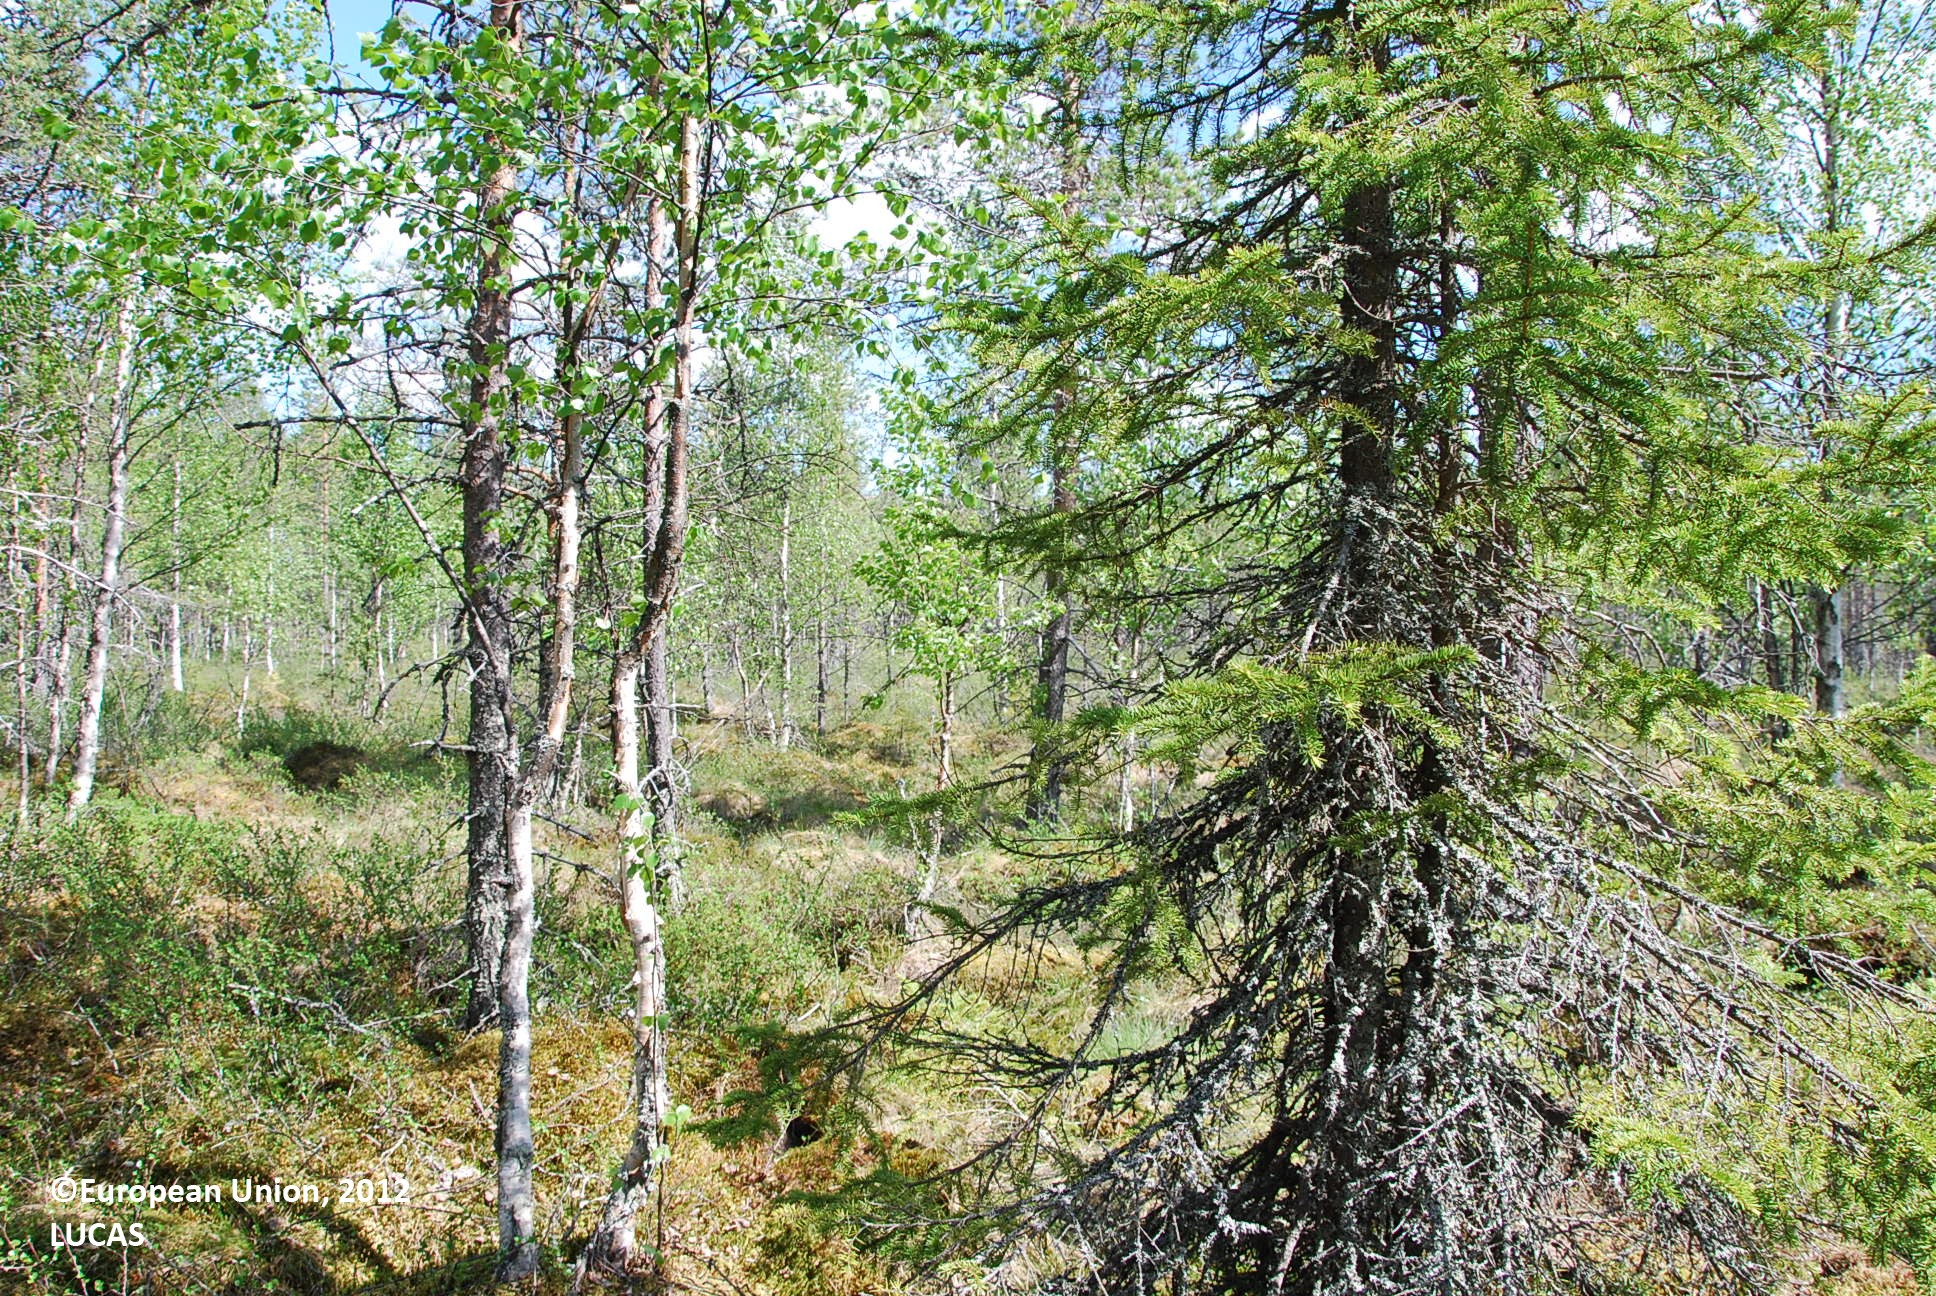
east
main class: Woodland
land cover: Pine dominated mixed woodland
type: boreal forest
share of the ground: 50 - 75 %
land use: Forestry
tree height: > 5 m
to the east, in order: Pine dominated mixed woodland; Ditches and canals; Grassland without tree/shrub cover; Ditches and canals; Broadleaved woodland; Tracks; Other mixed woodland; Ditches and canals; Other mixed woodland; Broadleaved woodland
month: June
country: FI
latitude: 66.0278
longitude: 27.6164
